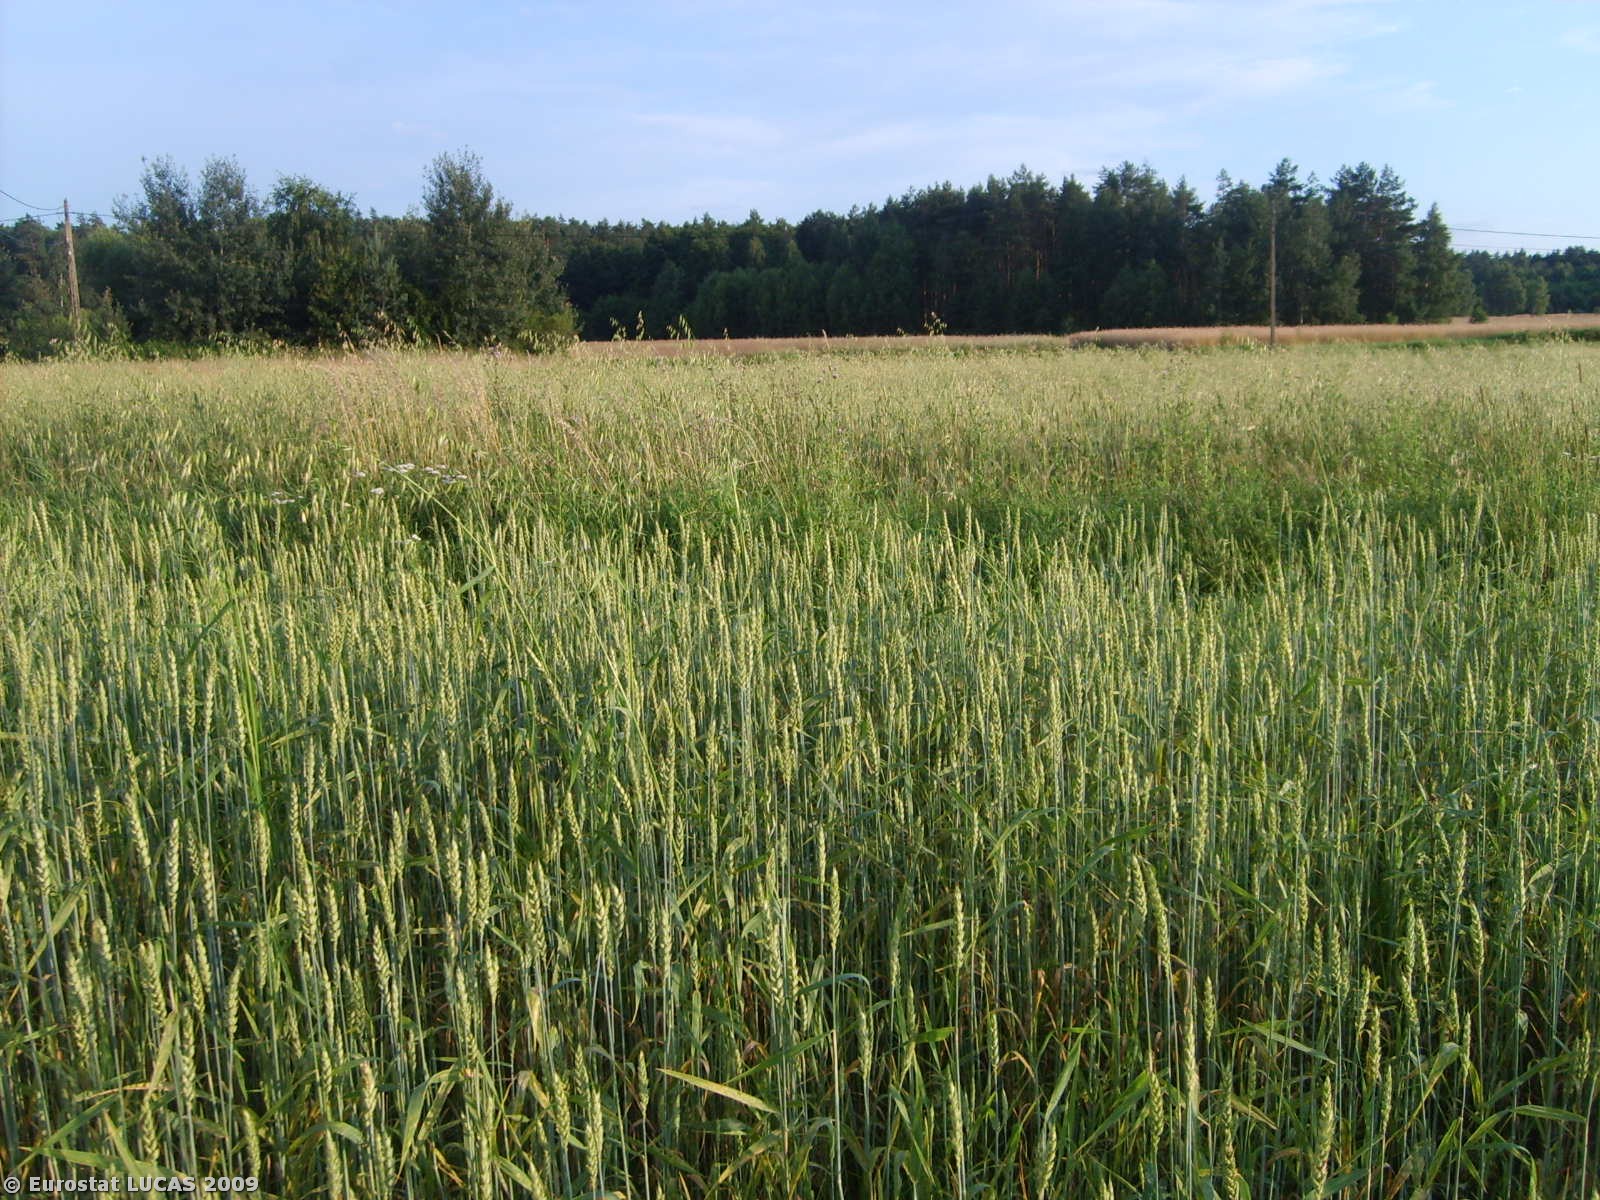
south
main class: Cropland
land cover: Common wheat
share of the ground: > 75 %
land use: Agriculture (excluding fallow land and kitchen gardens)
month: July
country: PL
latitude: 50.1418
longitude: 21.1699
